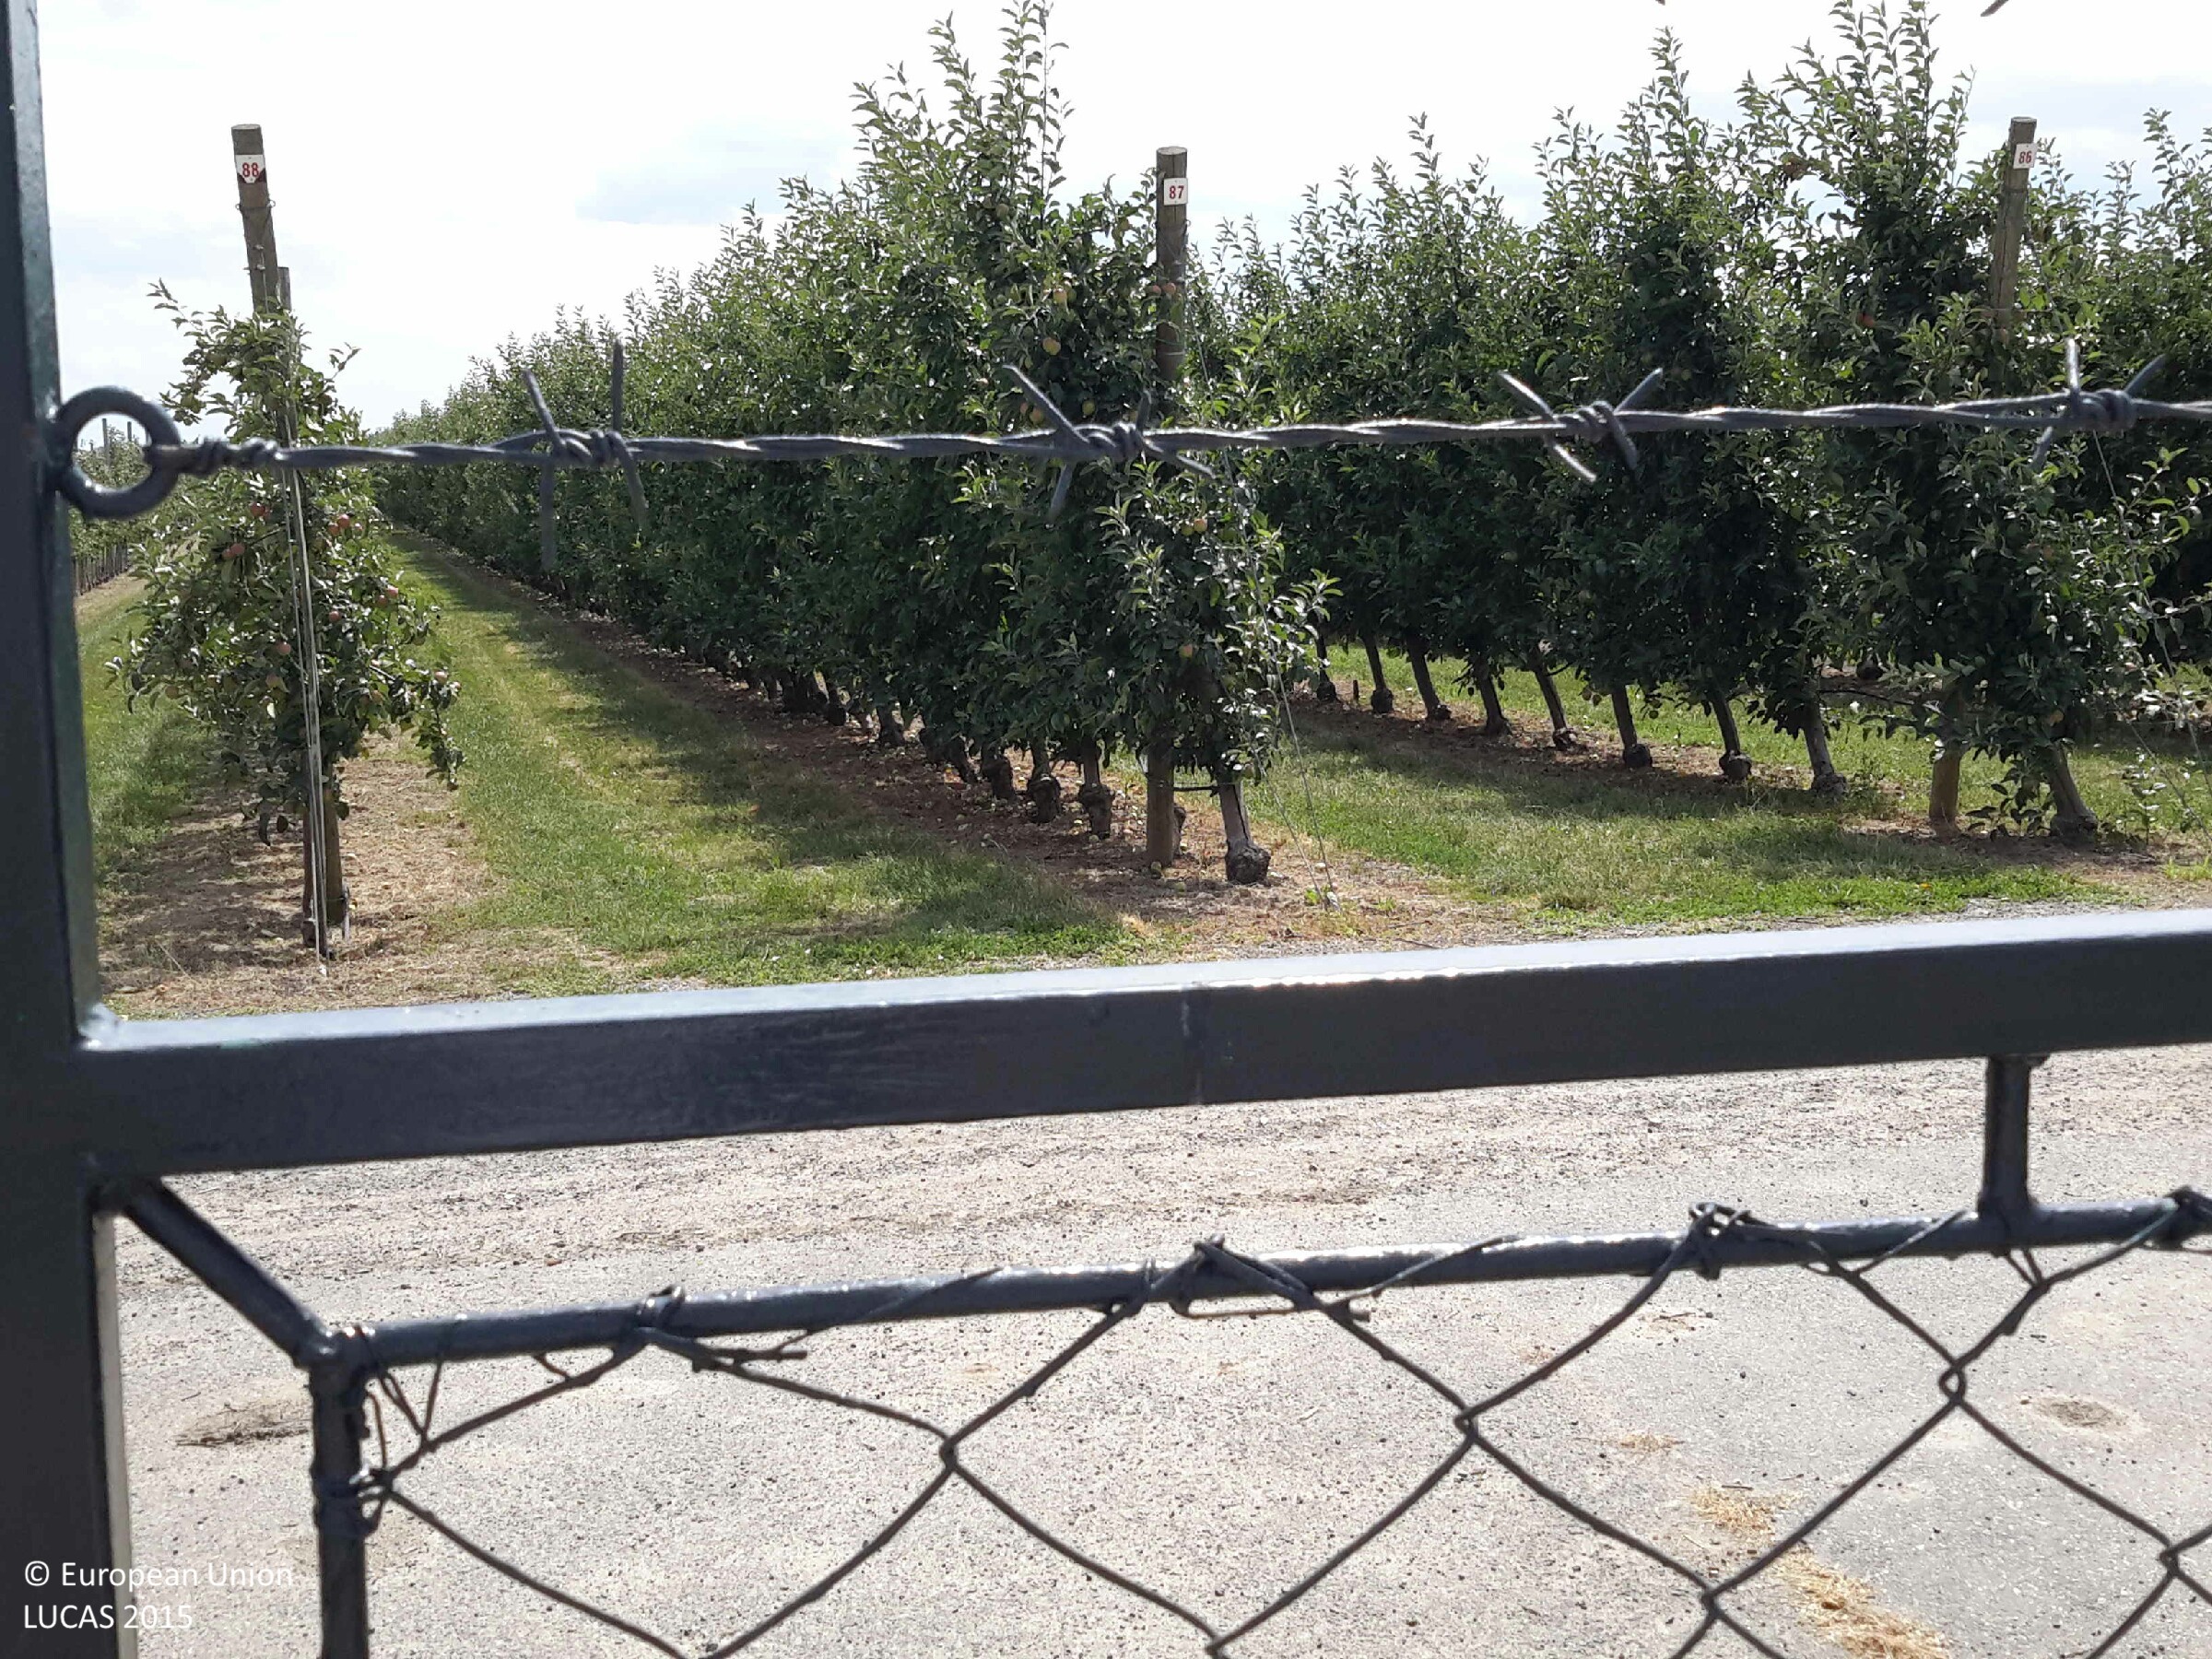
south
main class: Cropland
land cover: Apple fruit
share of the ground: 25 - 50 %
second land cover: Grassland without tree/shrub cover
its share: 50 - 75 %
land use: Agriculture (excluding fallow land and kitchen gardens)
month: July
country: HU
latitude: 47.5350
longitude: 17.2200
